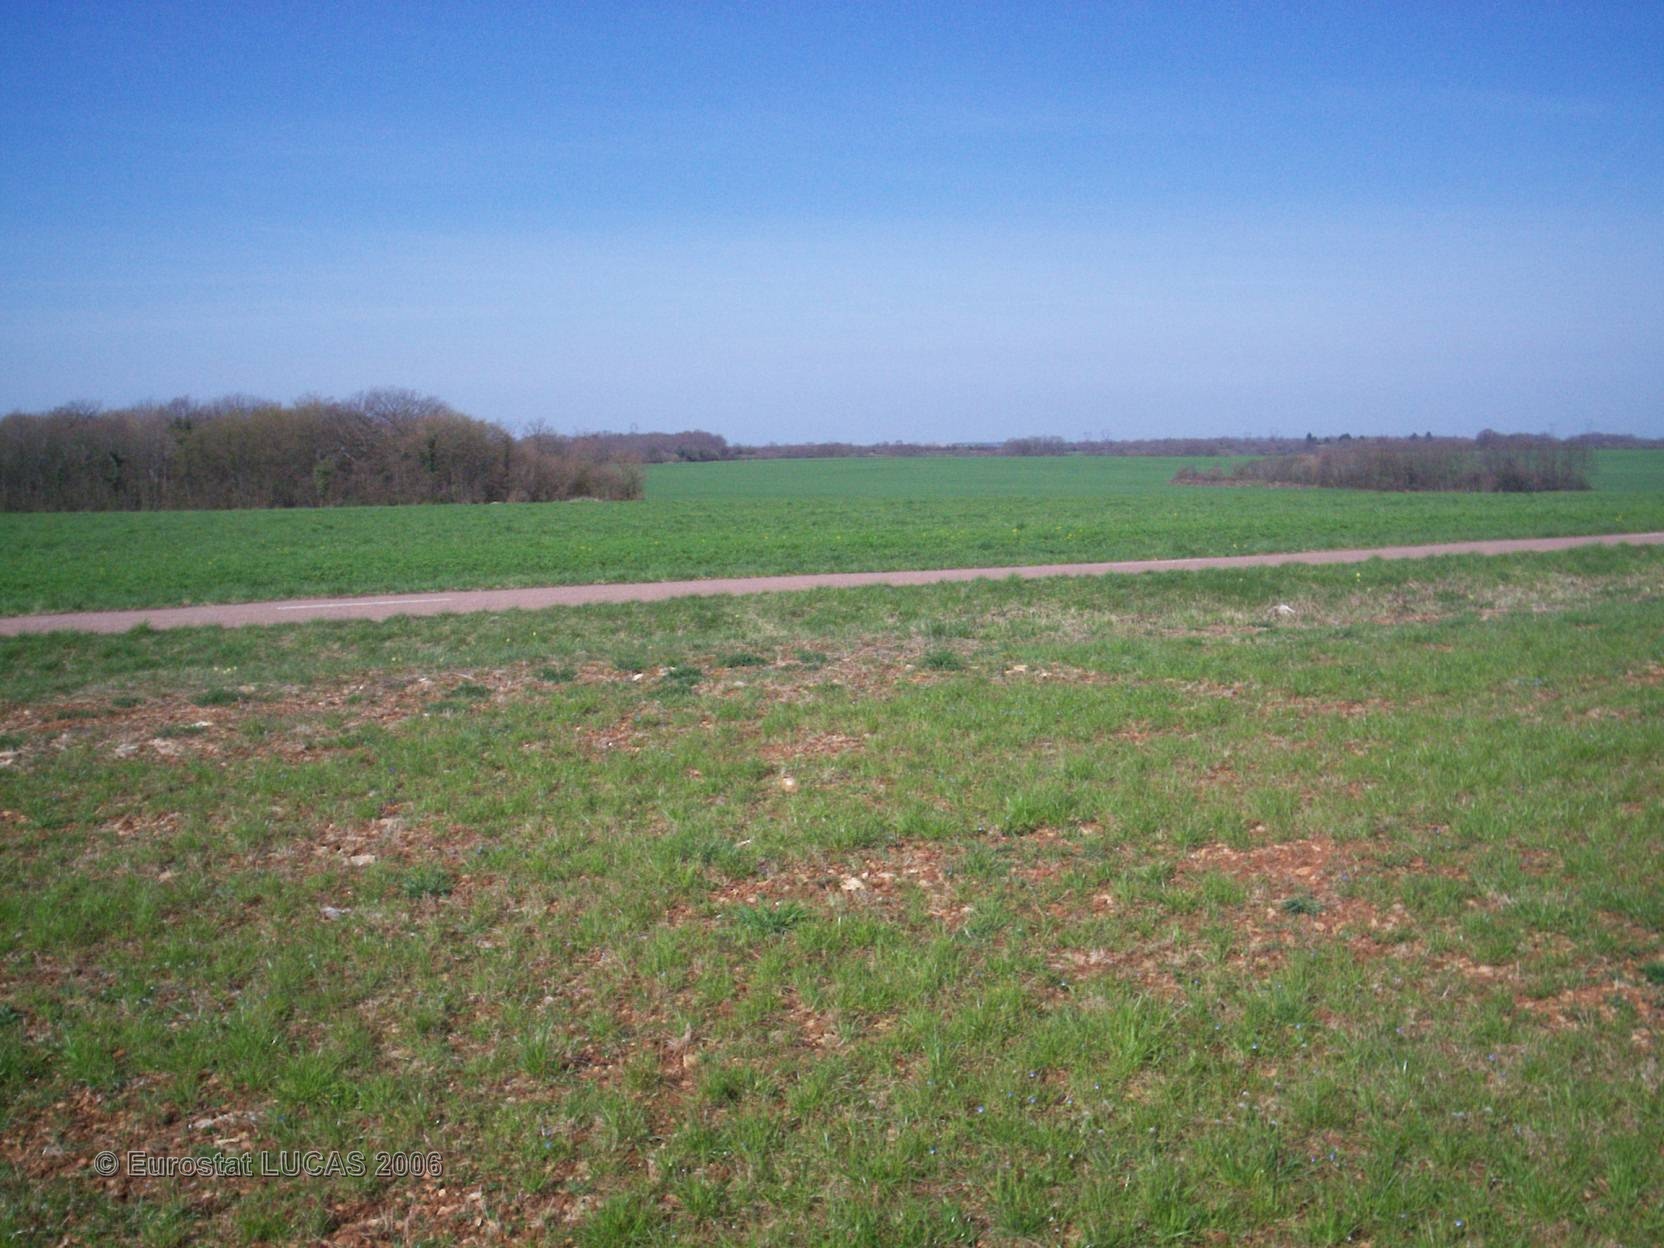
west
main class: Grassland
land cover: Grassland without tree/shrub cover
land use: Fallow land
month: April
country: FR
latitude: 47.4228
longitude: 4.5778
